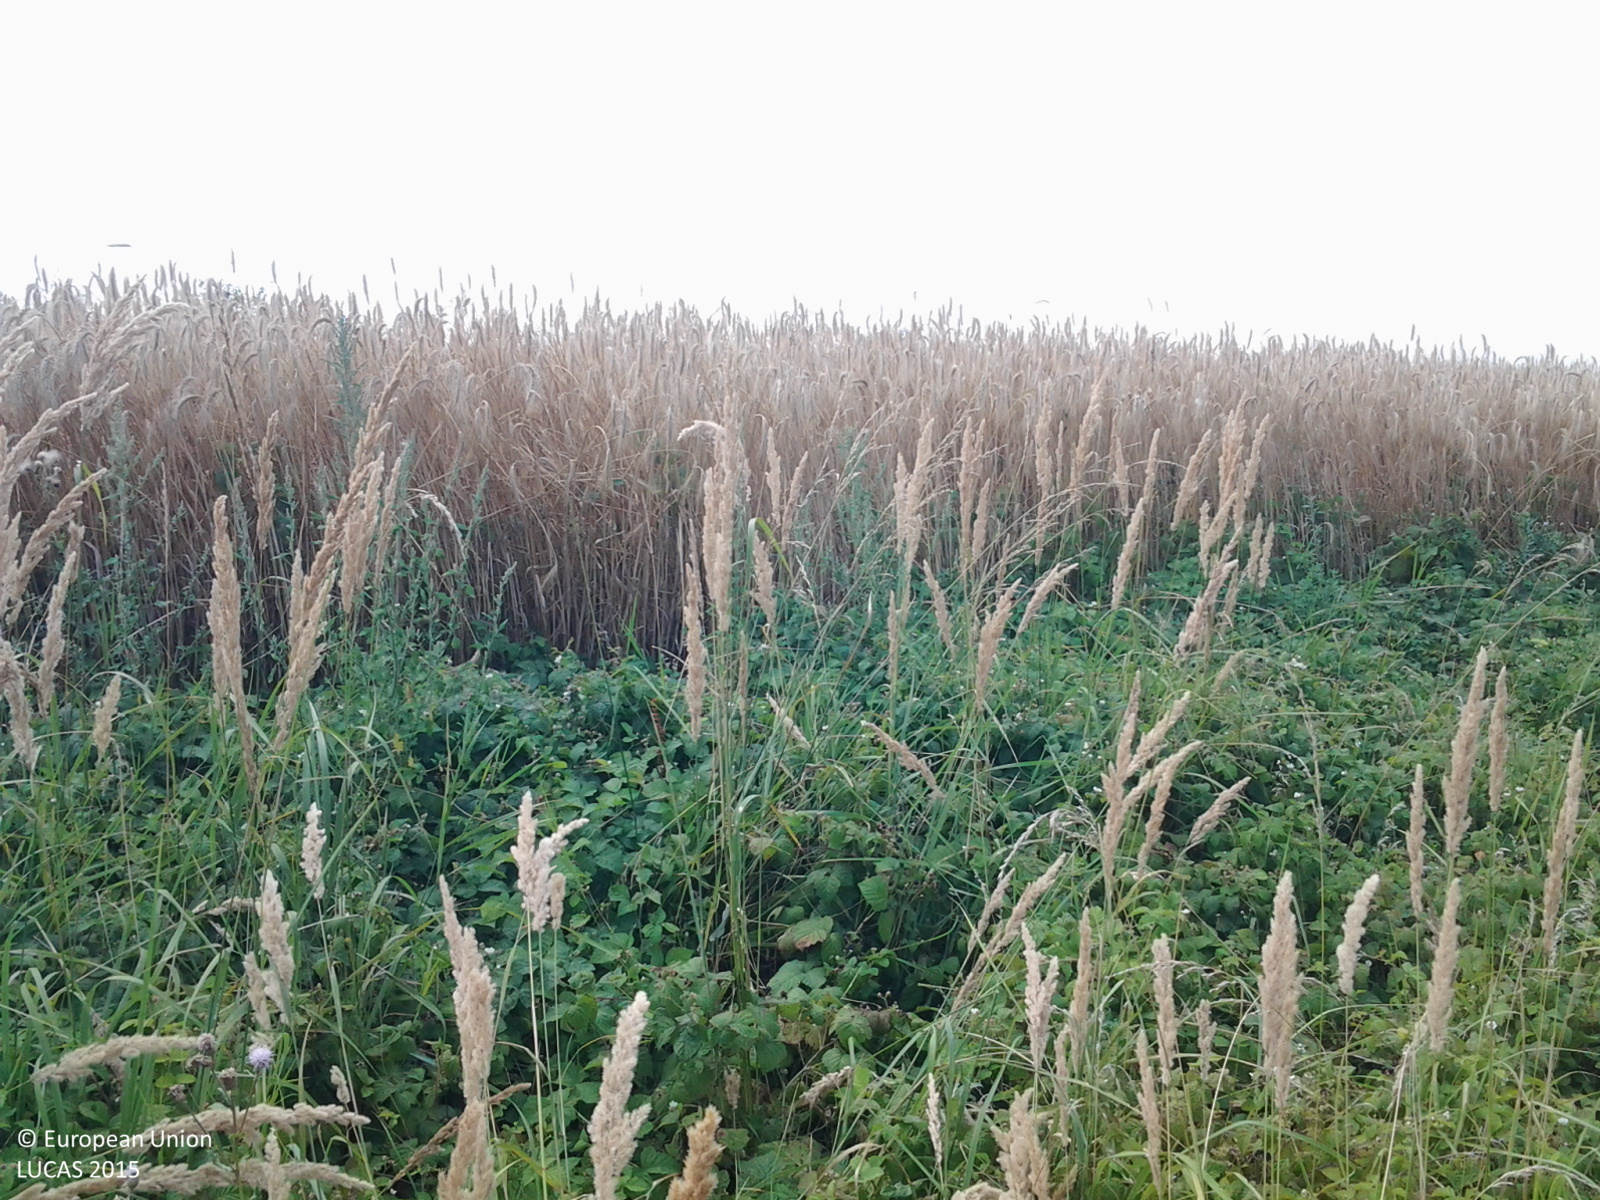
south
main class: Grassland
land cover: Grassland with sparse tree/shrub cover
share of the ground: > 75 %
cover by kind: herbaceous plants 85 %, shrubs 10 %, broadleaved forest trees 5 %
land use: Semi-natural and natural areas not in use
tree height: < 5 m
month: July
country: HU
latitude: 47.1083
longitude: 20.4524
